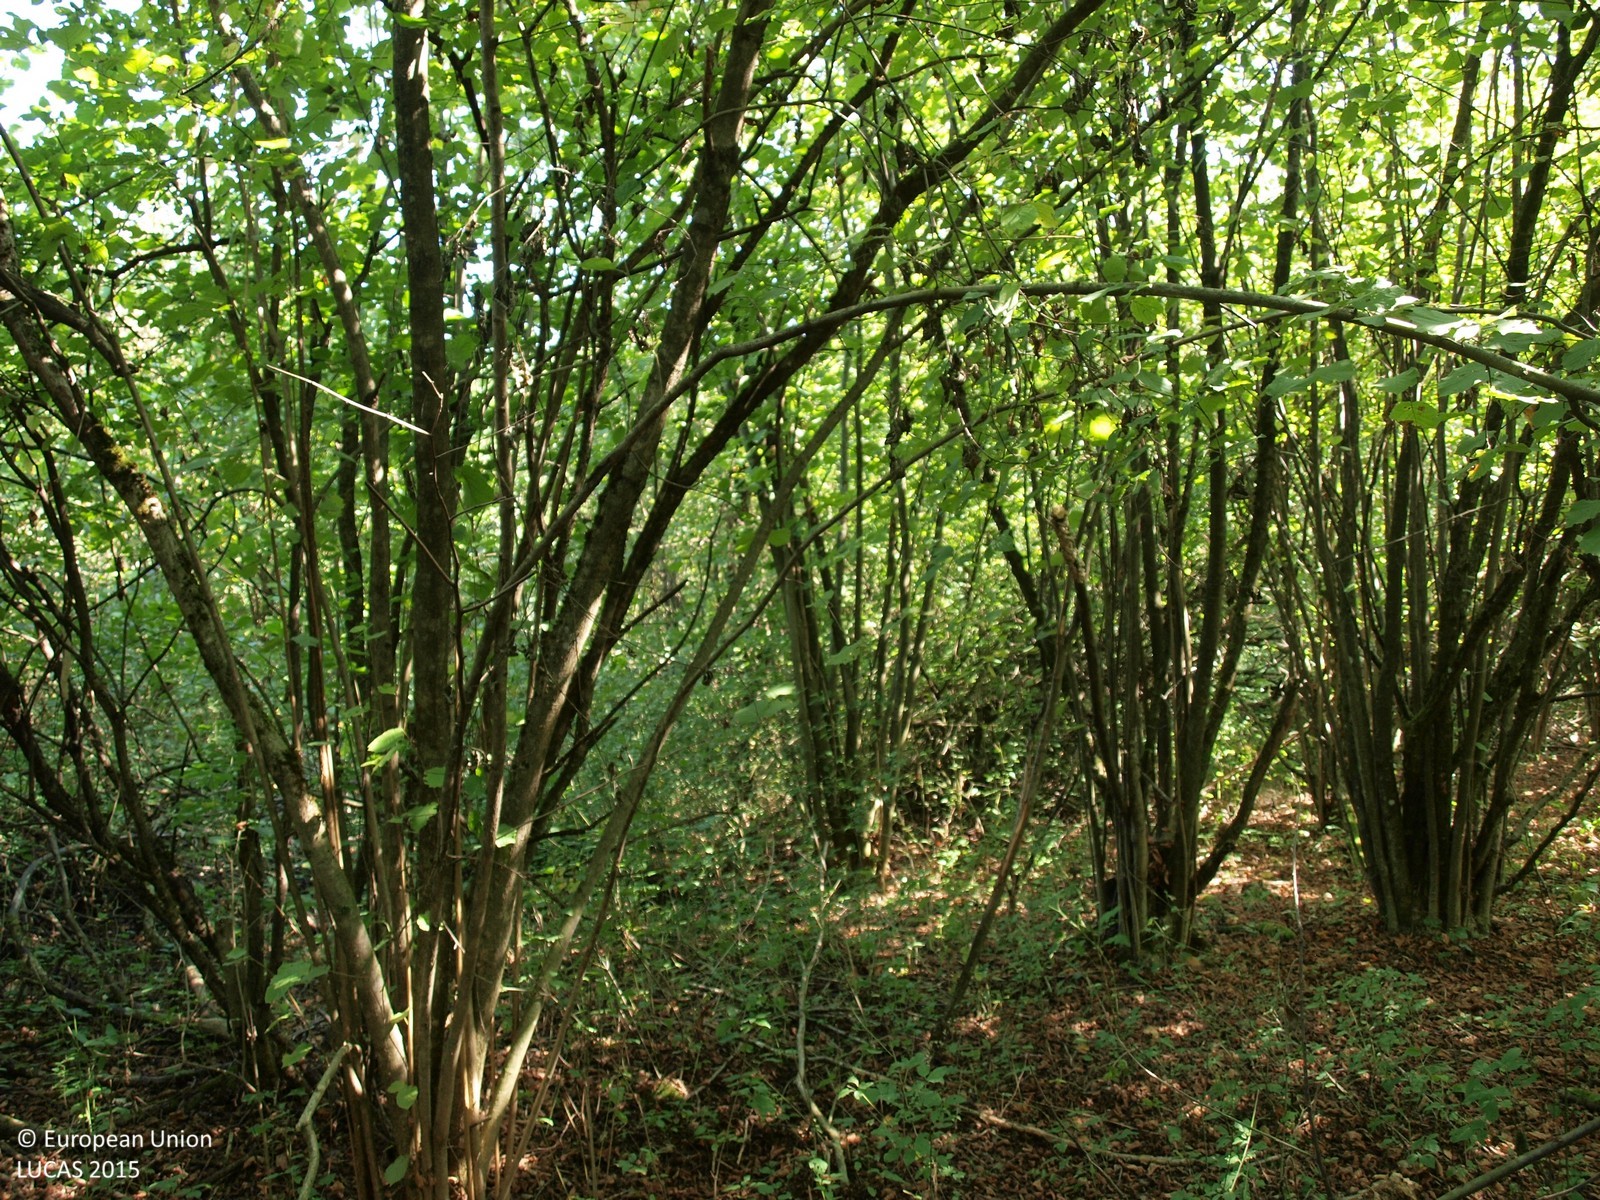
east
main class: Woodland
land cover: Broadleaved woodland
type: mesophytic deciduous forest
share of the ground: > 75 %
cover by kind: broadleaved forest trees 100 %
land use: Forestry
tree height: > 5 m
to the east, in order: Broadleaved woodland
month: August
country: HR
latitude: 45.6636
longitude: 16.5317
